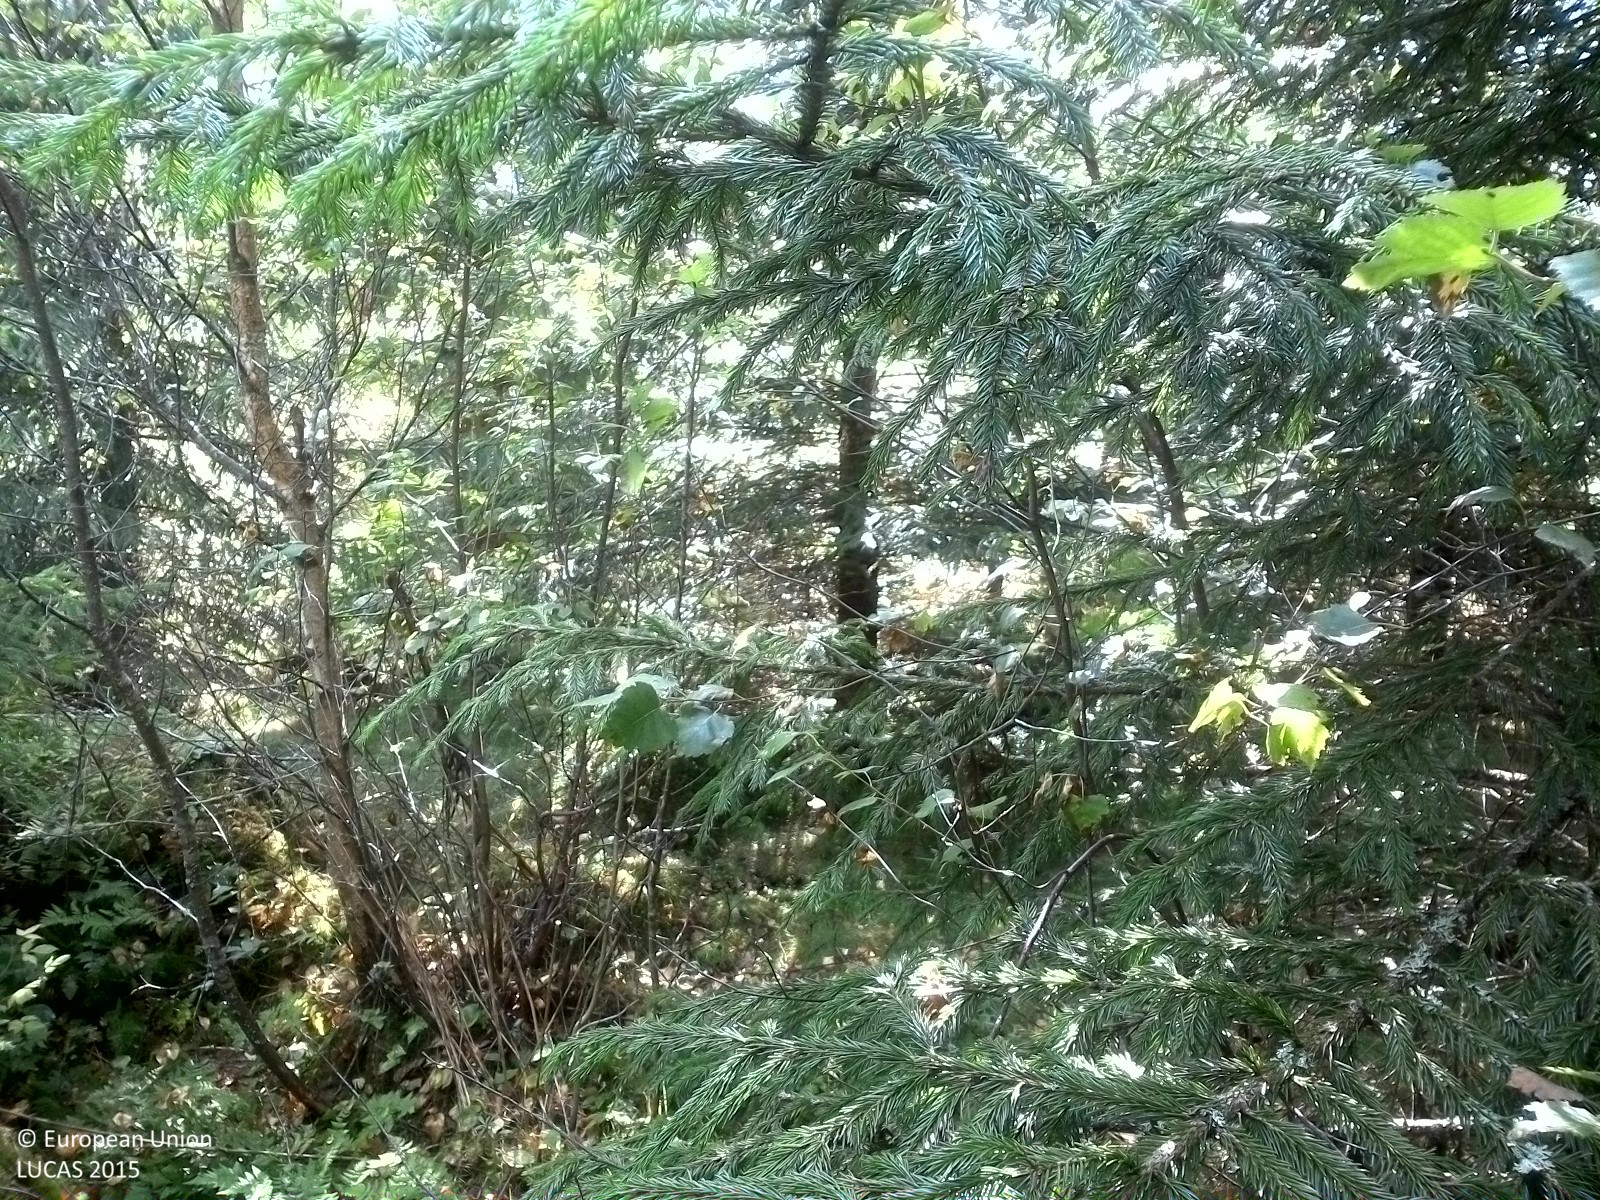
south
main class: Woodland
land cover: Spruce dominated mixed woodland
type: boreal forest
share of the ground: 50 - 75 %
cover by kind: coniferous forest trees 40 %, broadleaved forest trees 30 %, herbaceous plants 20 %, lichens and mosses 10 %
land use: Forestry
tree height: < 5 m
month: August
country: SE
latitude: 58.6132
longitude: 15.0029
